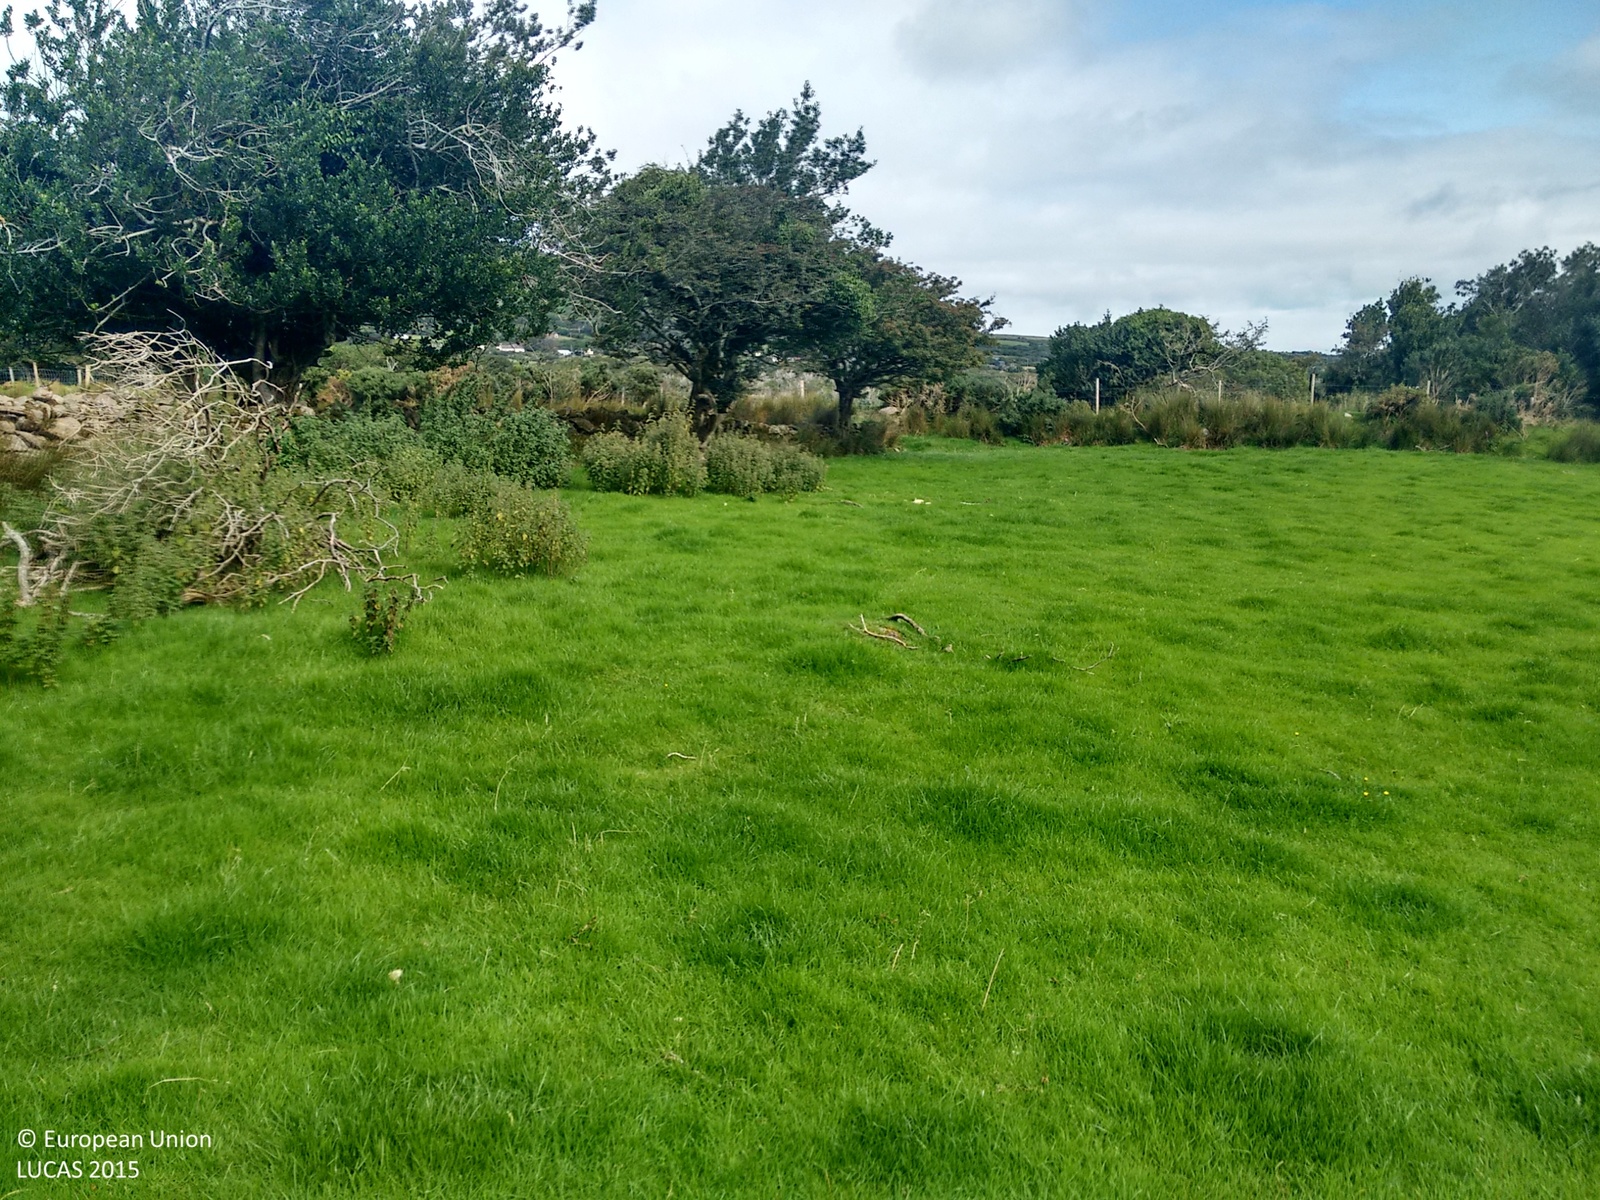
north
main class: Grassland
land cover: Grassland without tree/shrub cover
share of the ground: > 75 %
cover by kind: herbaceous plants 95 %, shrubs 5 %
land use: Agriculture (excluding fallow land and kitchen gardens)
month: September
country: IE
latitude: 52.2308
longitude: -10.1893
